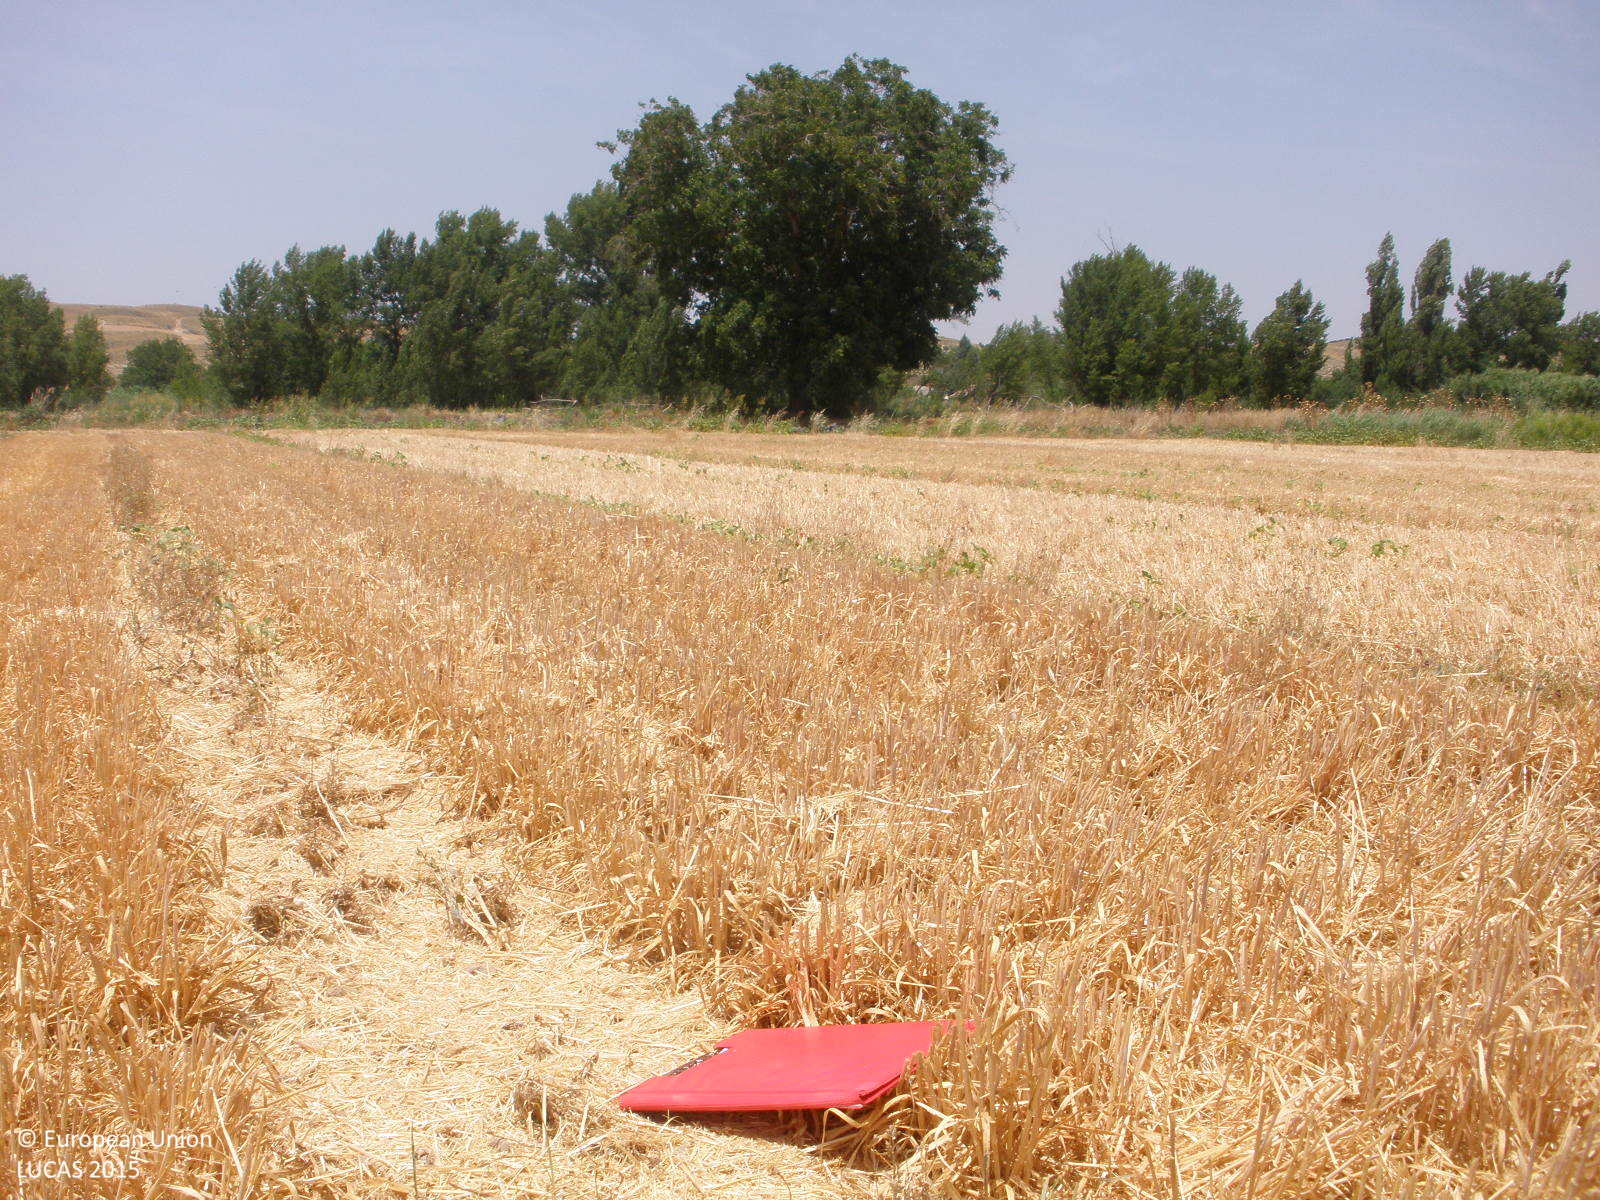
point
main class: Cropland
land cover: Barley
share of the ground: < 10 %
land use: Agriculture (excluding fallow land and kitchen gardens)
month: July
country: ES
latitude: 40.1509
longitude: -3.5200
